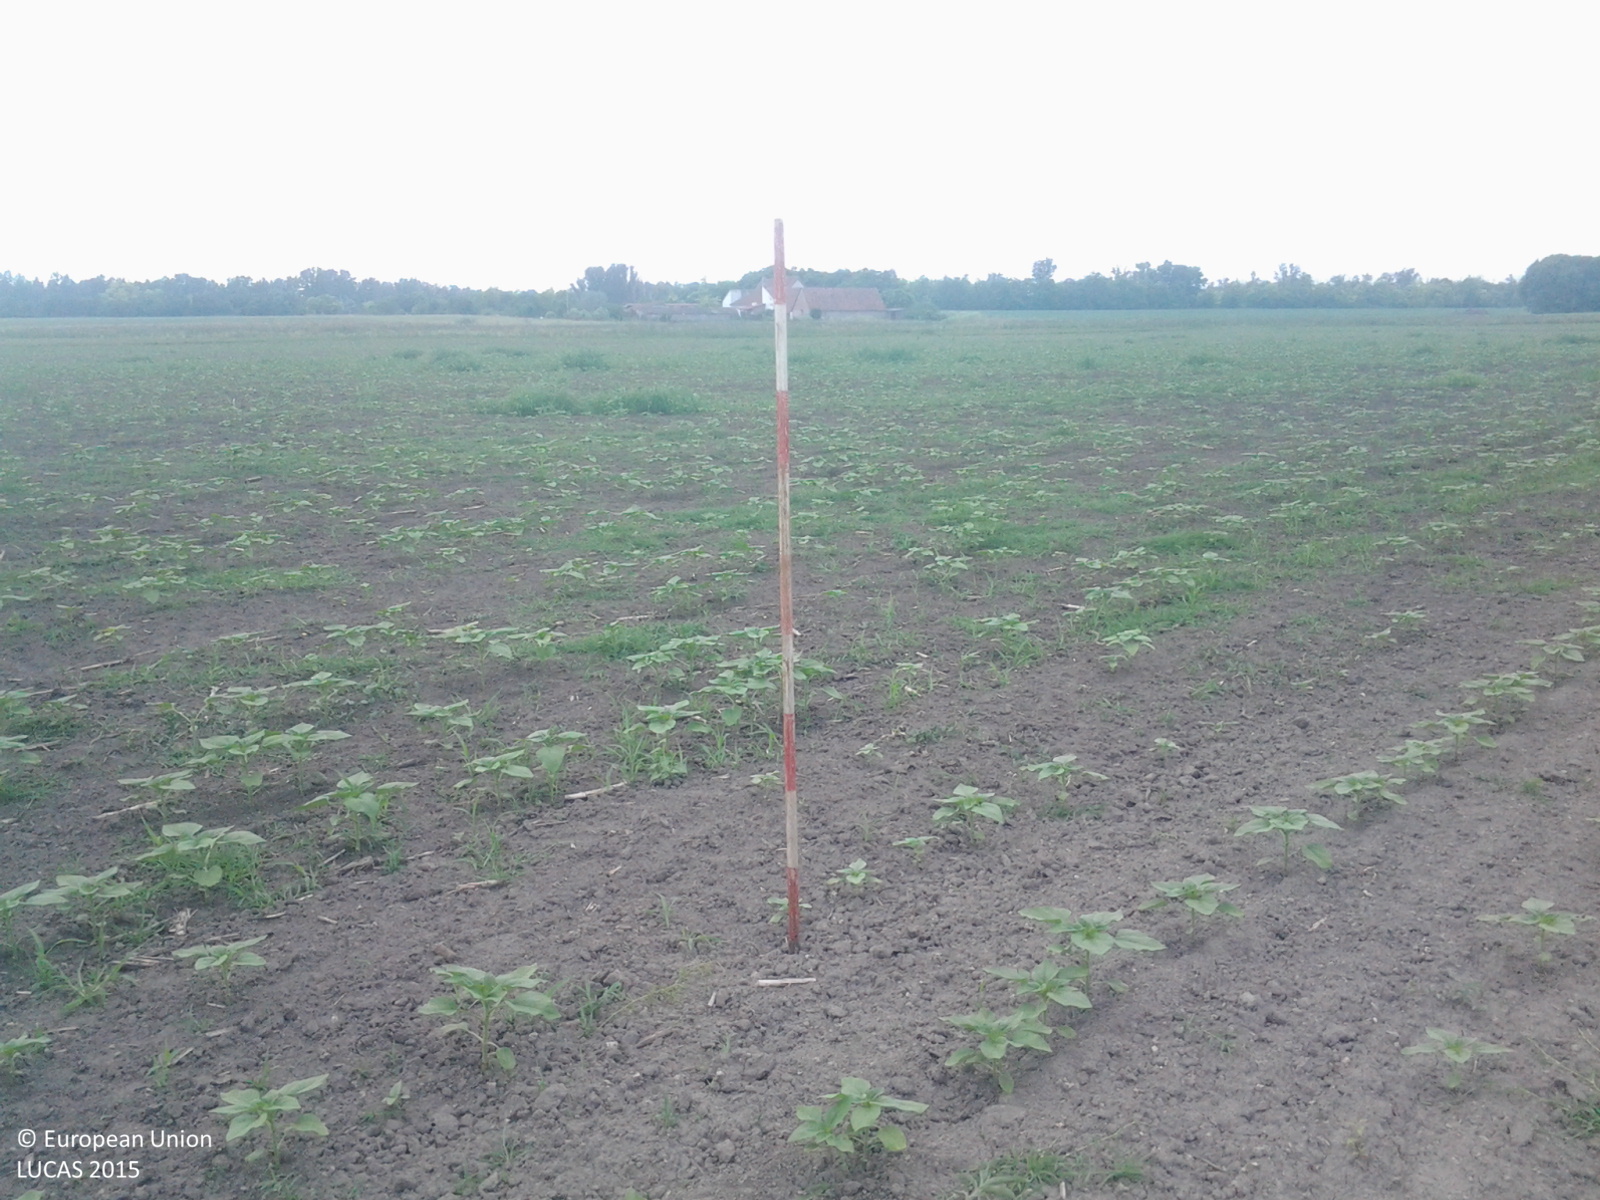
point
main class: Cropland
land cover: Sunflower
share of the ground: < 10 %
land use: Agriculture (excluding fallow land and kitchen gardens)
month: June
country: HU
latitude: 46.8821
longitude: 19.7712
